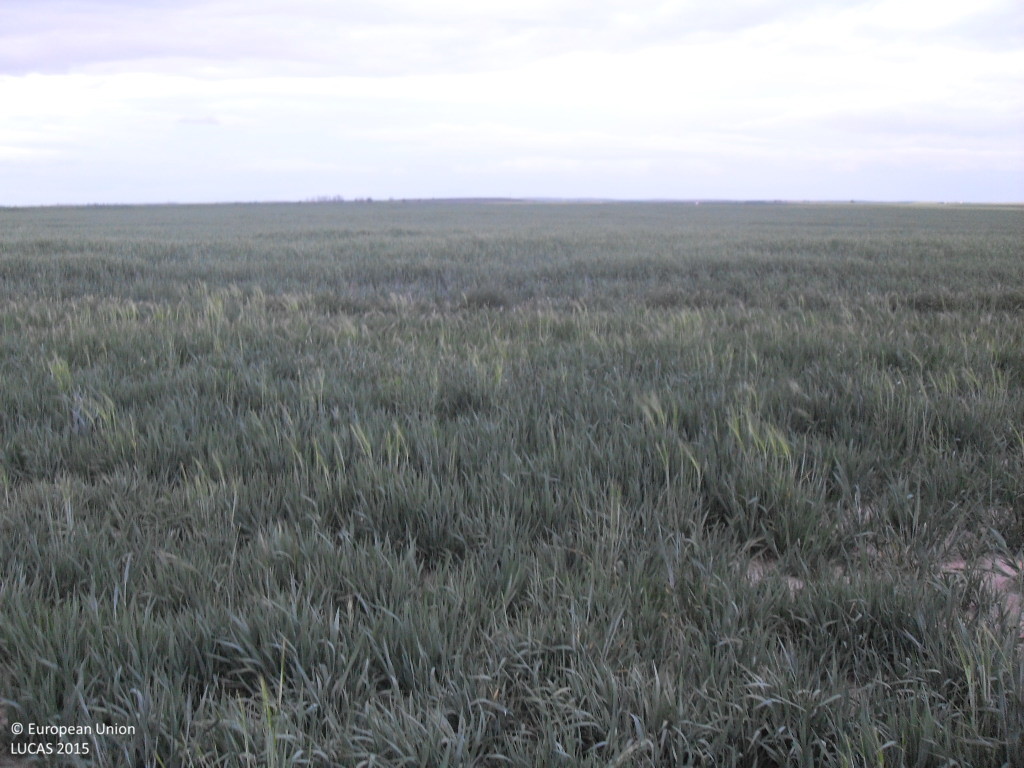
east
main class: Cropland
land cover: Oats
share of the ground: > 75 %
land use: Agriculture (excluding fallow land and kitchen gardens)
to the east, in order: Oats; Grass margins; Rye
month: April
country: ES
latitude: 40.9781
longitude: -5.2461
